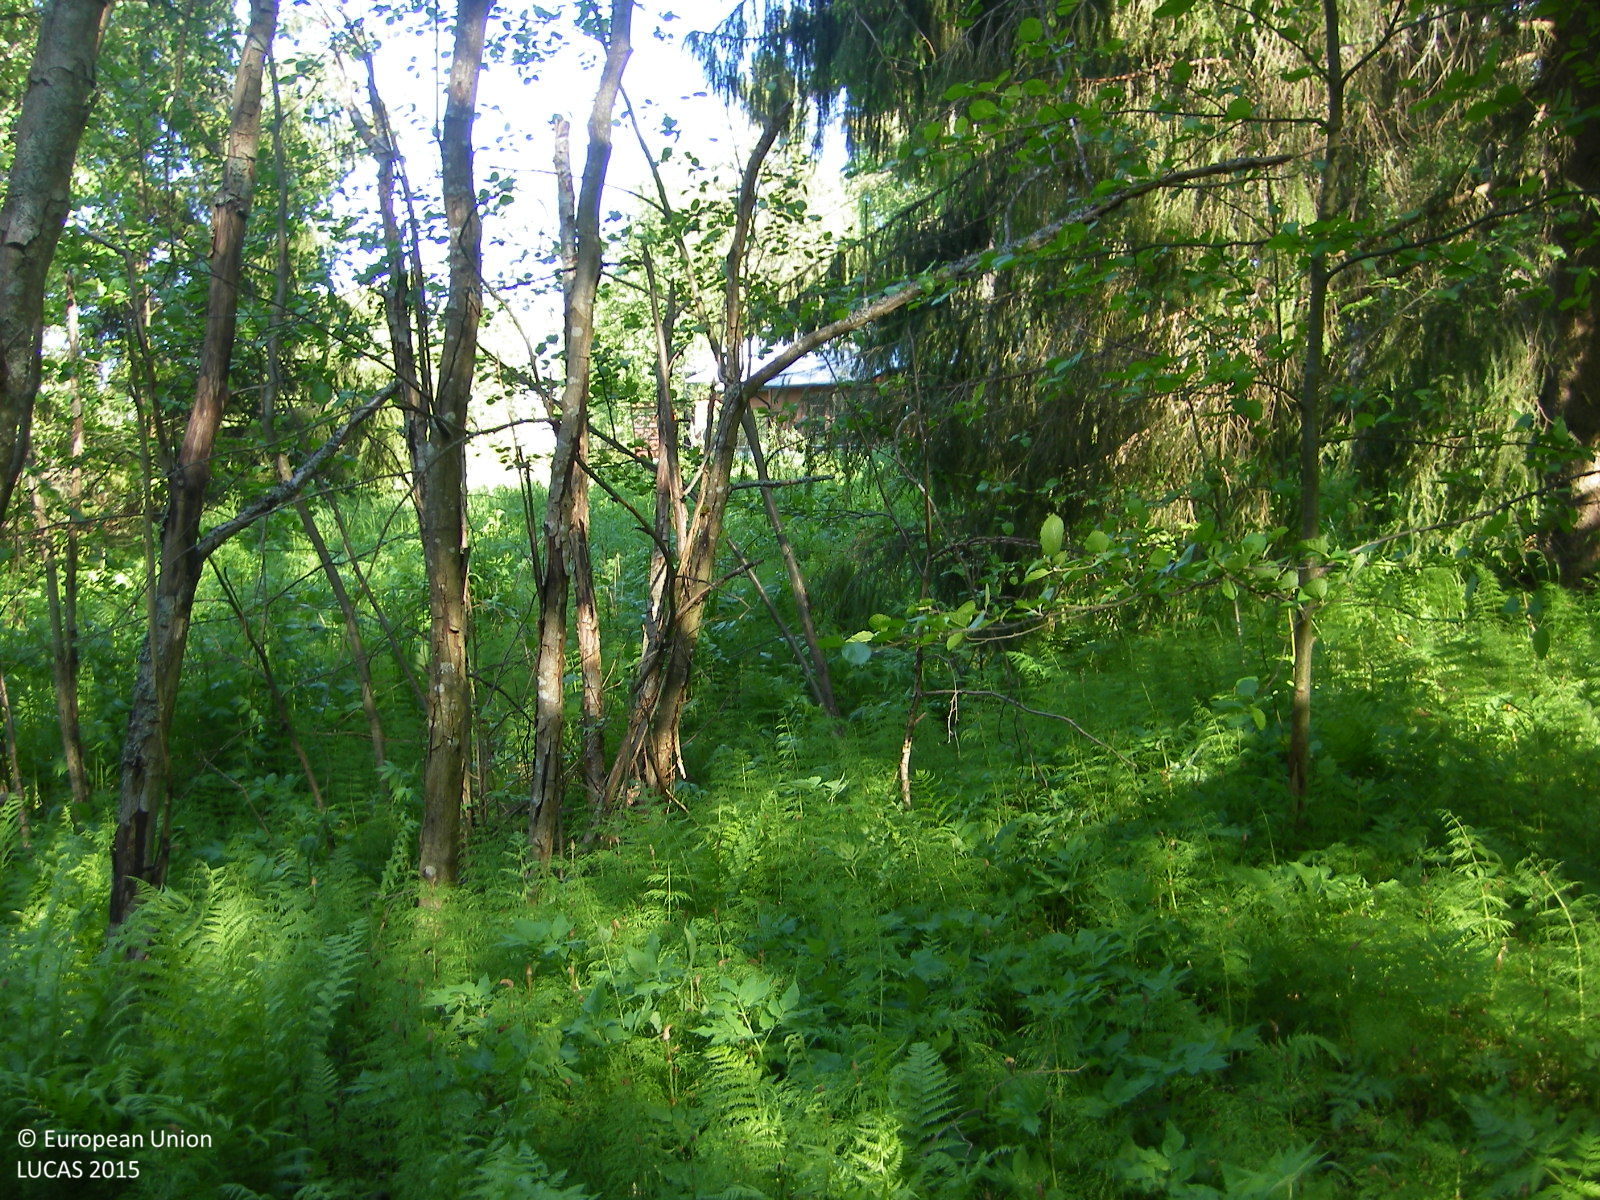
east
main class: Woodland
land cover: Spruce dominated mixed woodland
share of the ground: 50 - 75 %
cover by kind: coniferous forest trees 35 %, broadleaved forest trees 35 %, herbaceous plants 30 %
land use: Forestry
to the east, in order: Spruce dominated mixed woodland; Ditches and canals; Grassland without tree/shrub cover; Electric lines; Grassland without tree/shrub cover; Grass margins; Artificial constructions in urban areas; Grass margins; Ditches and canals; Grass margins; Other bare soil
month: June
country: FI
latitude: 60.4666
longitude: 24.9013
